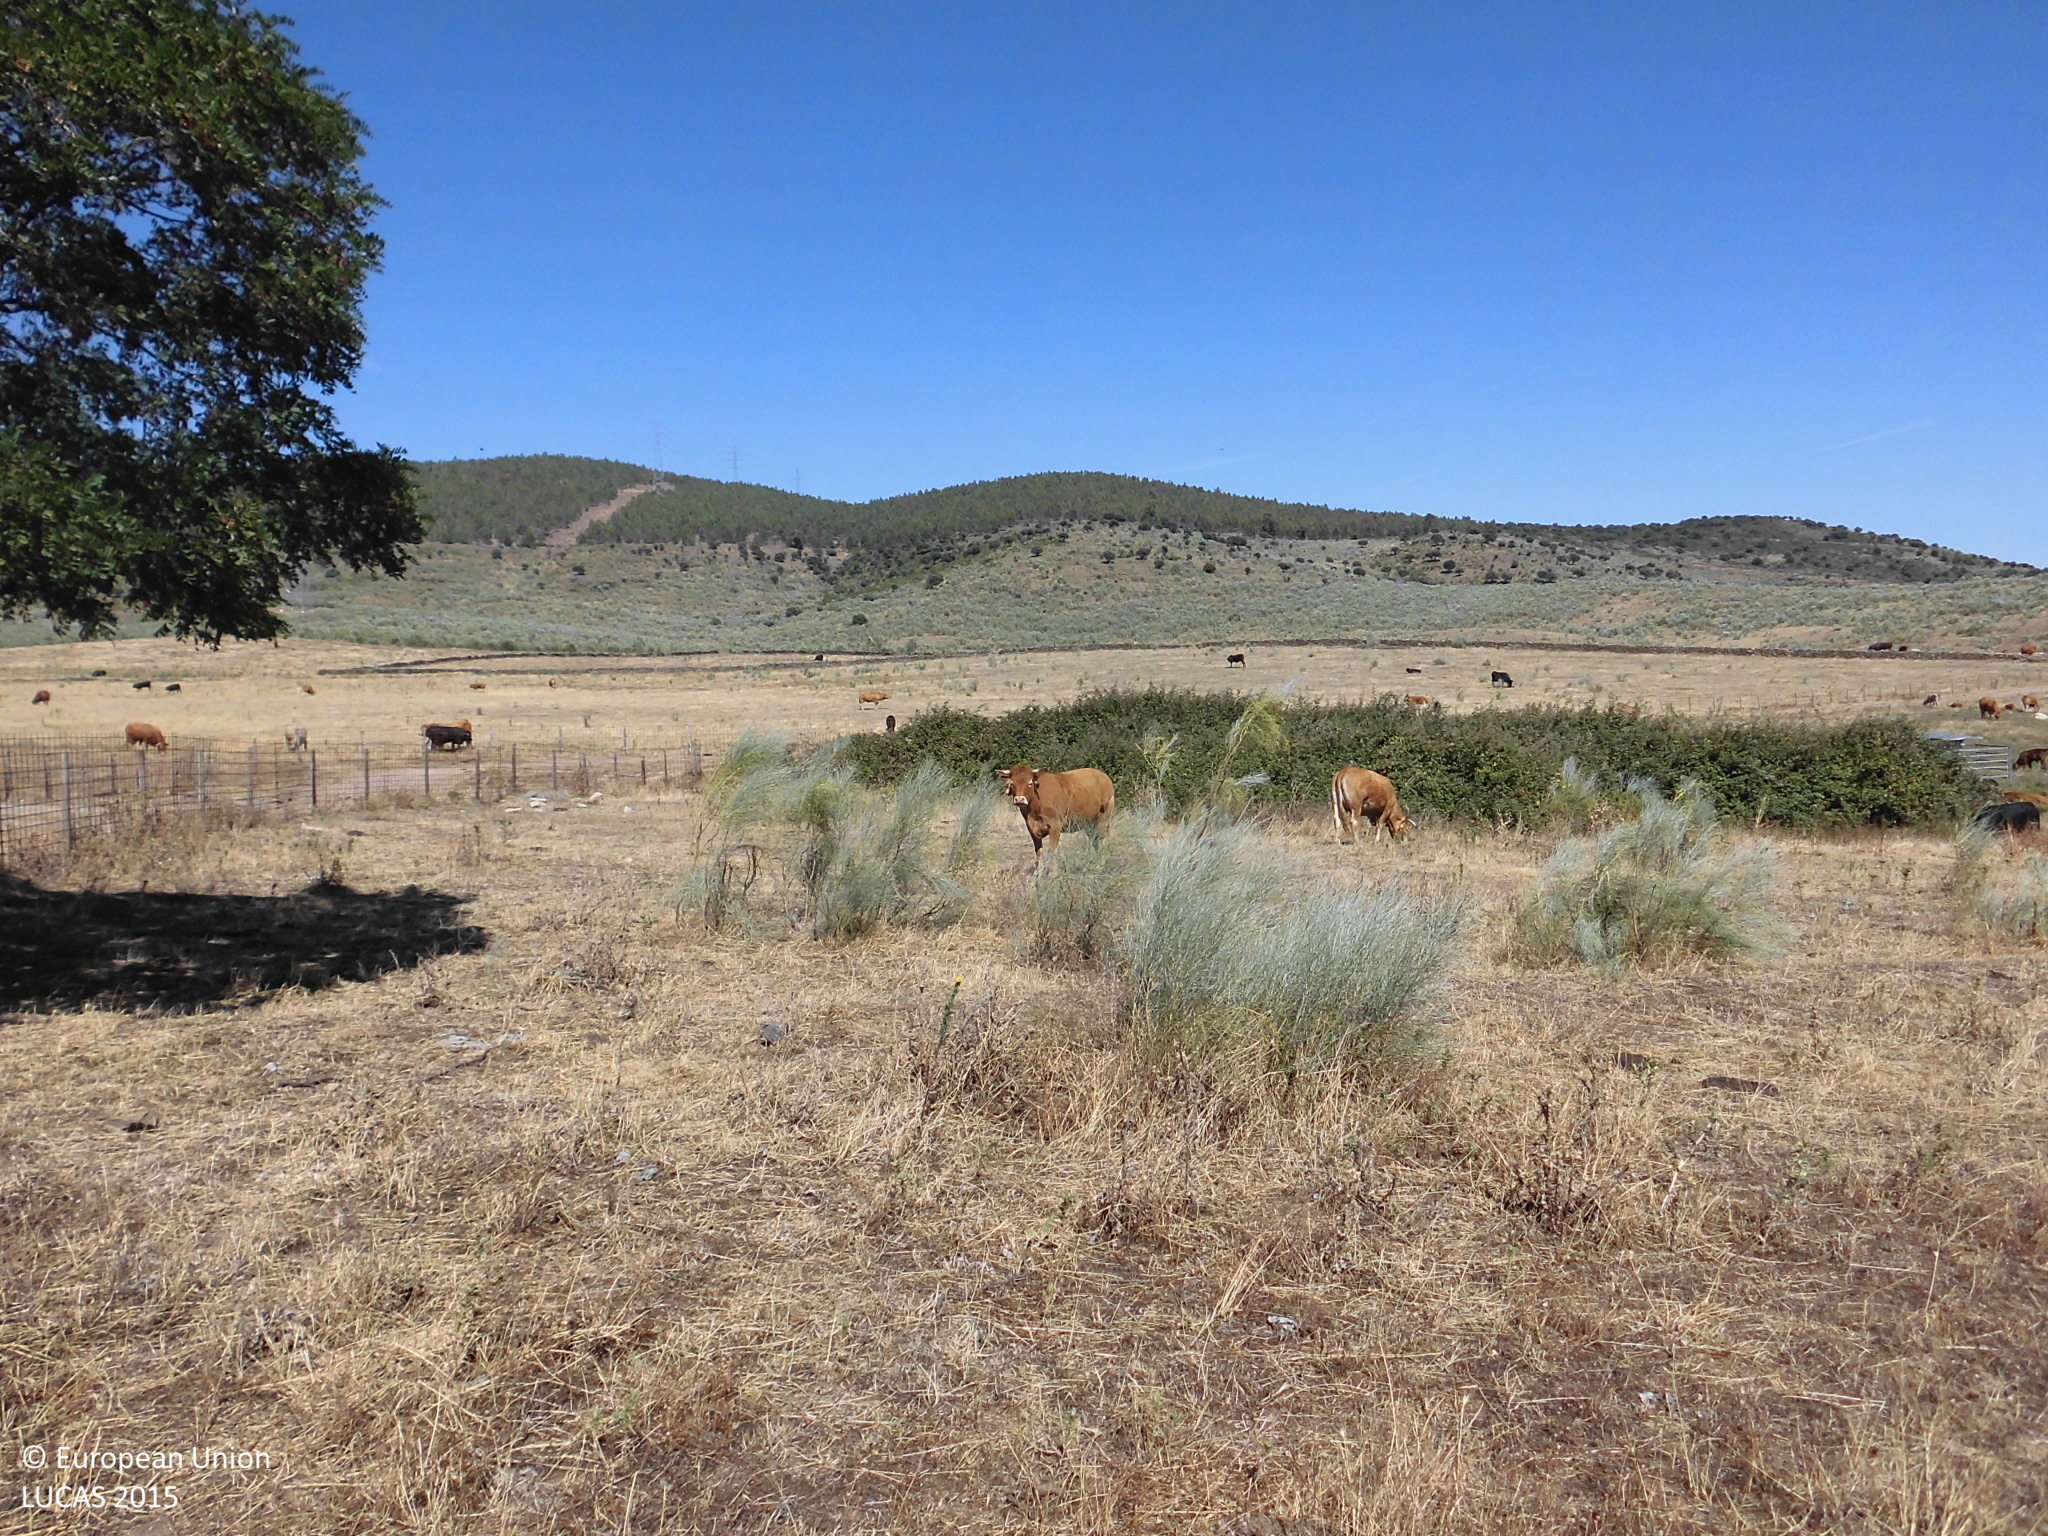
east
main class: Grassland
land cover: Grassland with sparse tree/shrub cover
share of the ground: > 75 %
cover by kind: herbaceous plants 85 %, unconsolidated bare surface 10 %, broadleaved forest trees 5 %
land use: Agriculture (excluding fallow land and kitchen gardens)
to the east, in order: Grassland with sparse tree/shrub cover; Shrubland without tree cover; Fences; Grassland without tree/shrub cover; Tracks; Grassland without tree/shrub cover; Dry stone walls; Grassland without tree/shrub cover
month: June
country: ES
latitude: 40.0020
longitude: -6.0595
